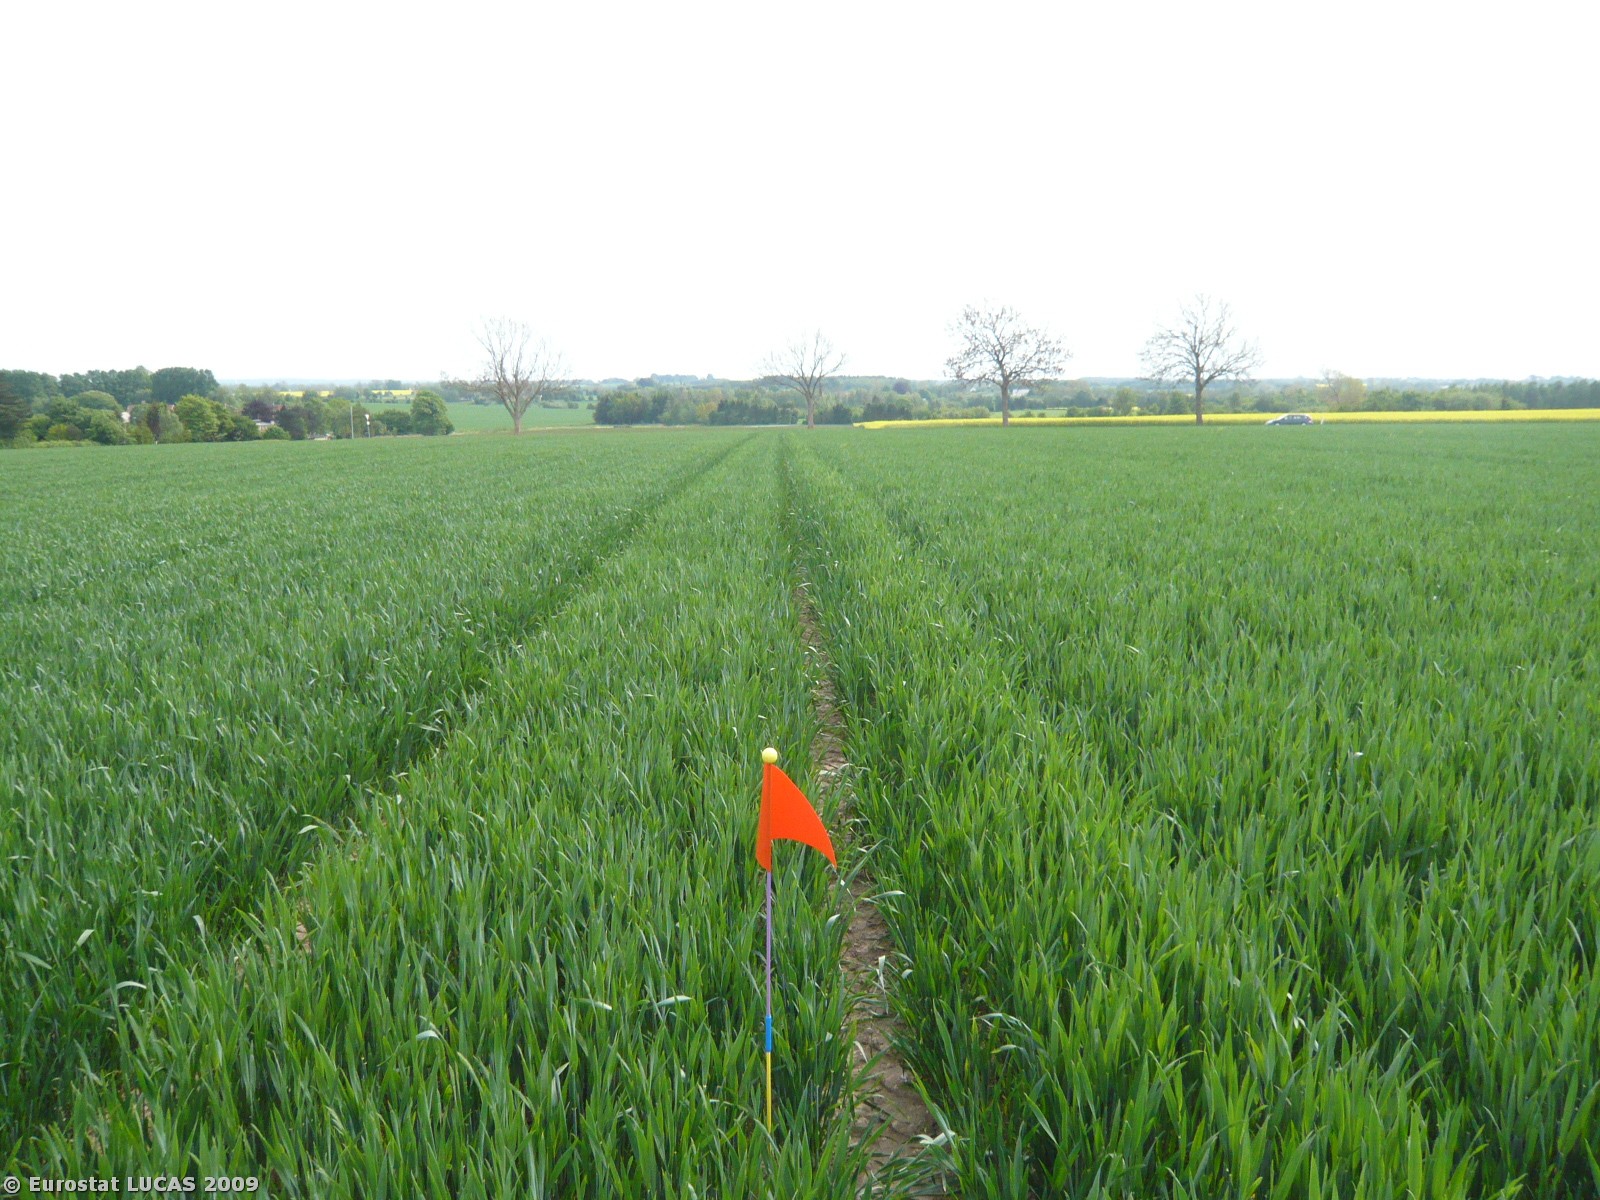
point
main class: Cropland
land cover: Common wheat
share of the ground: > 75 %
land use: Agriculture (excluding fallow land and kitchen gardens)
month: May
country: DK
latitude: 55.3834
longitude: 11.8453
